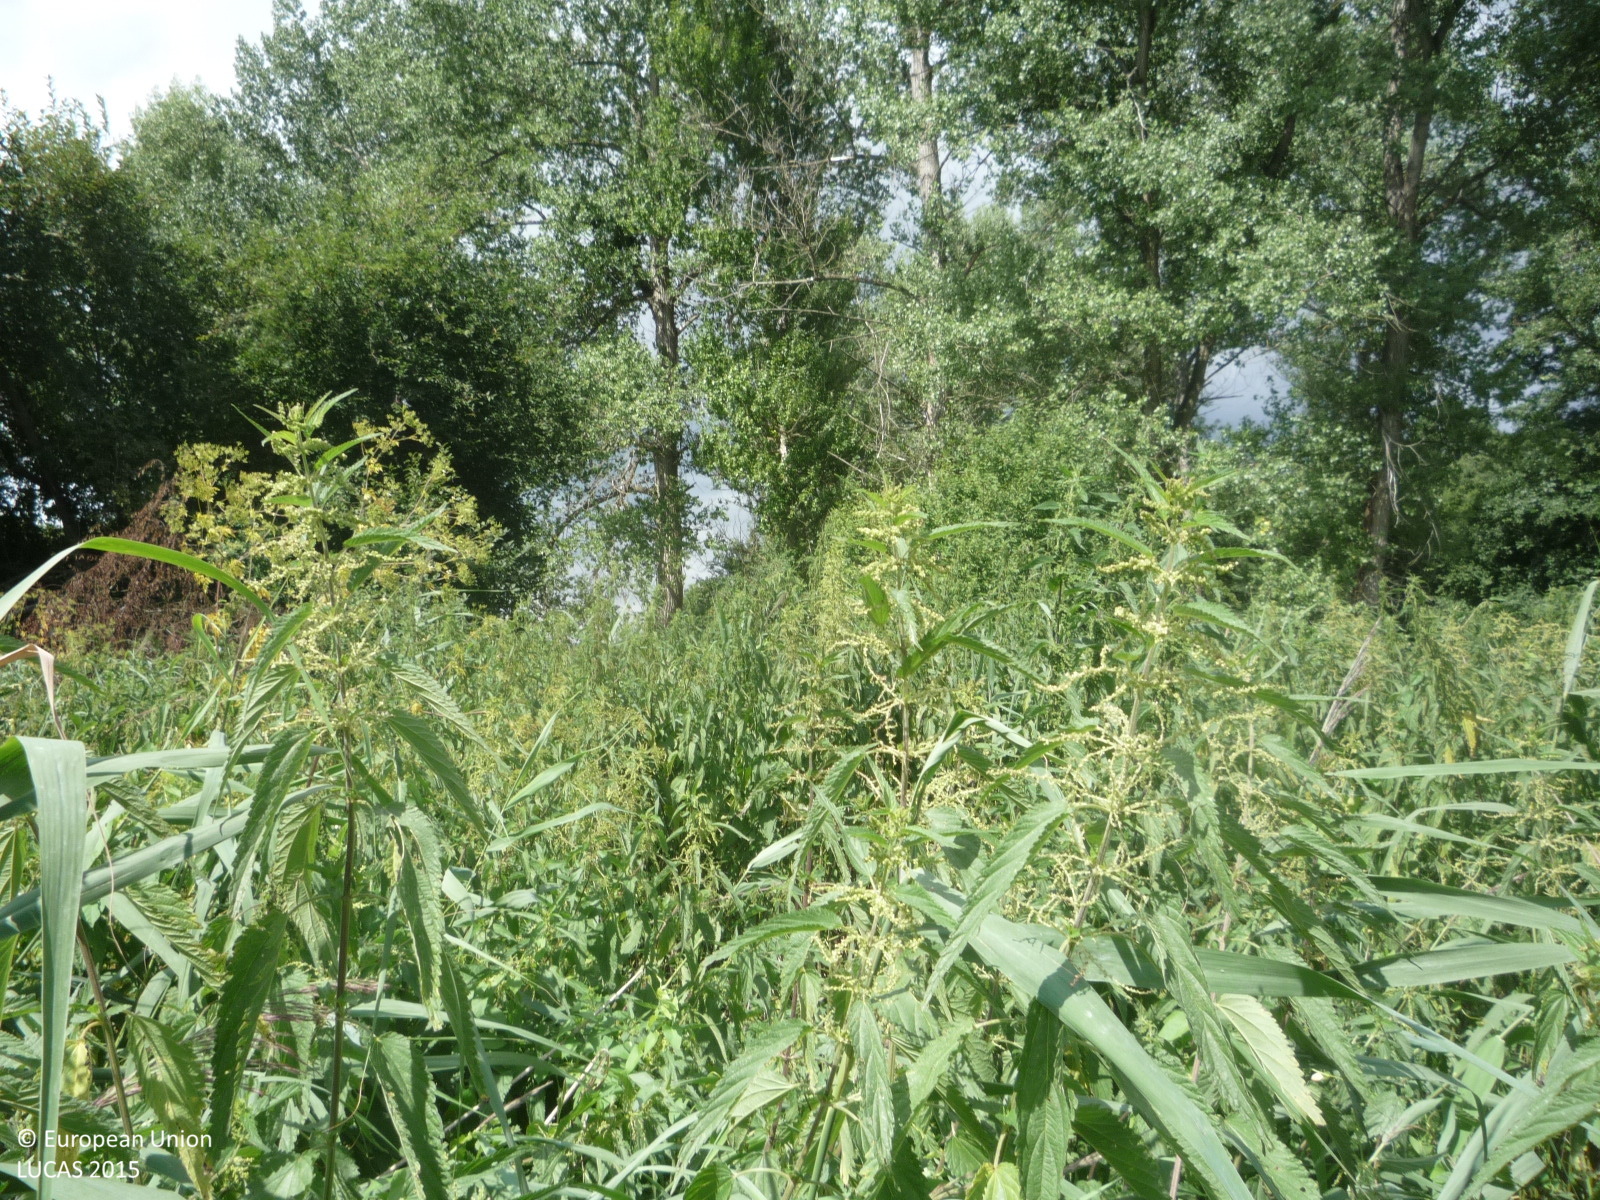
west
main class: Grassland
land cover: Spontaneously vegetated surfaces
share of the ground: > 75 %
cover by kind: herbaceous plants 100 %
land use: Semi-natural and natural areas not in use
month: July
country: CZ
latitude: 50.3365
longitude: 15.1876
